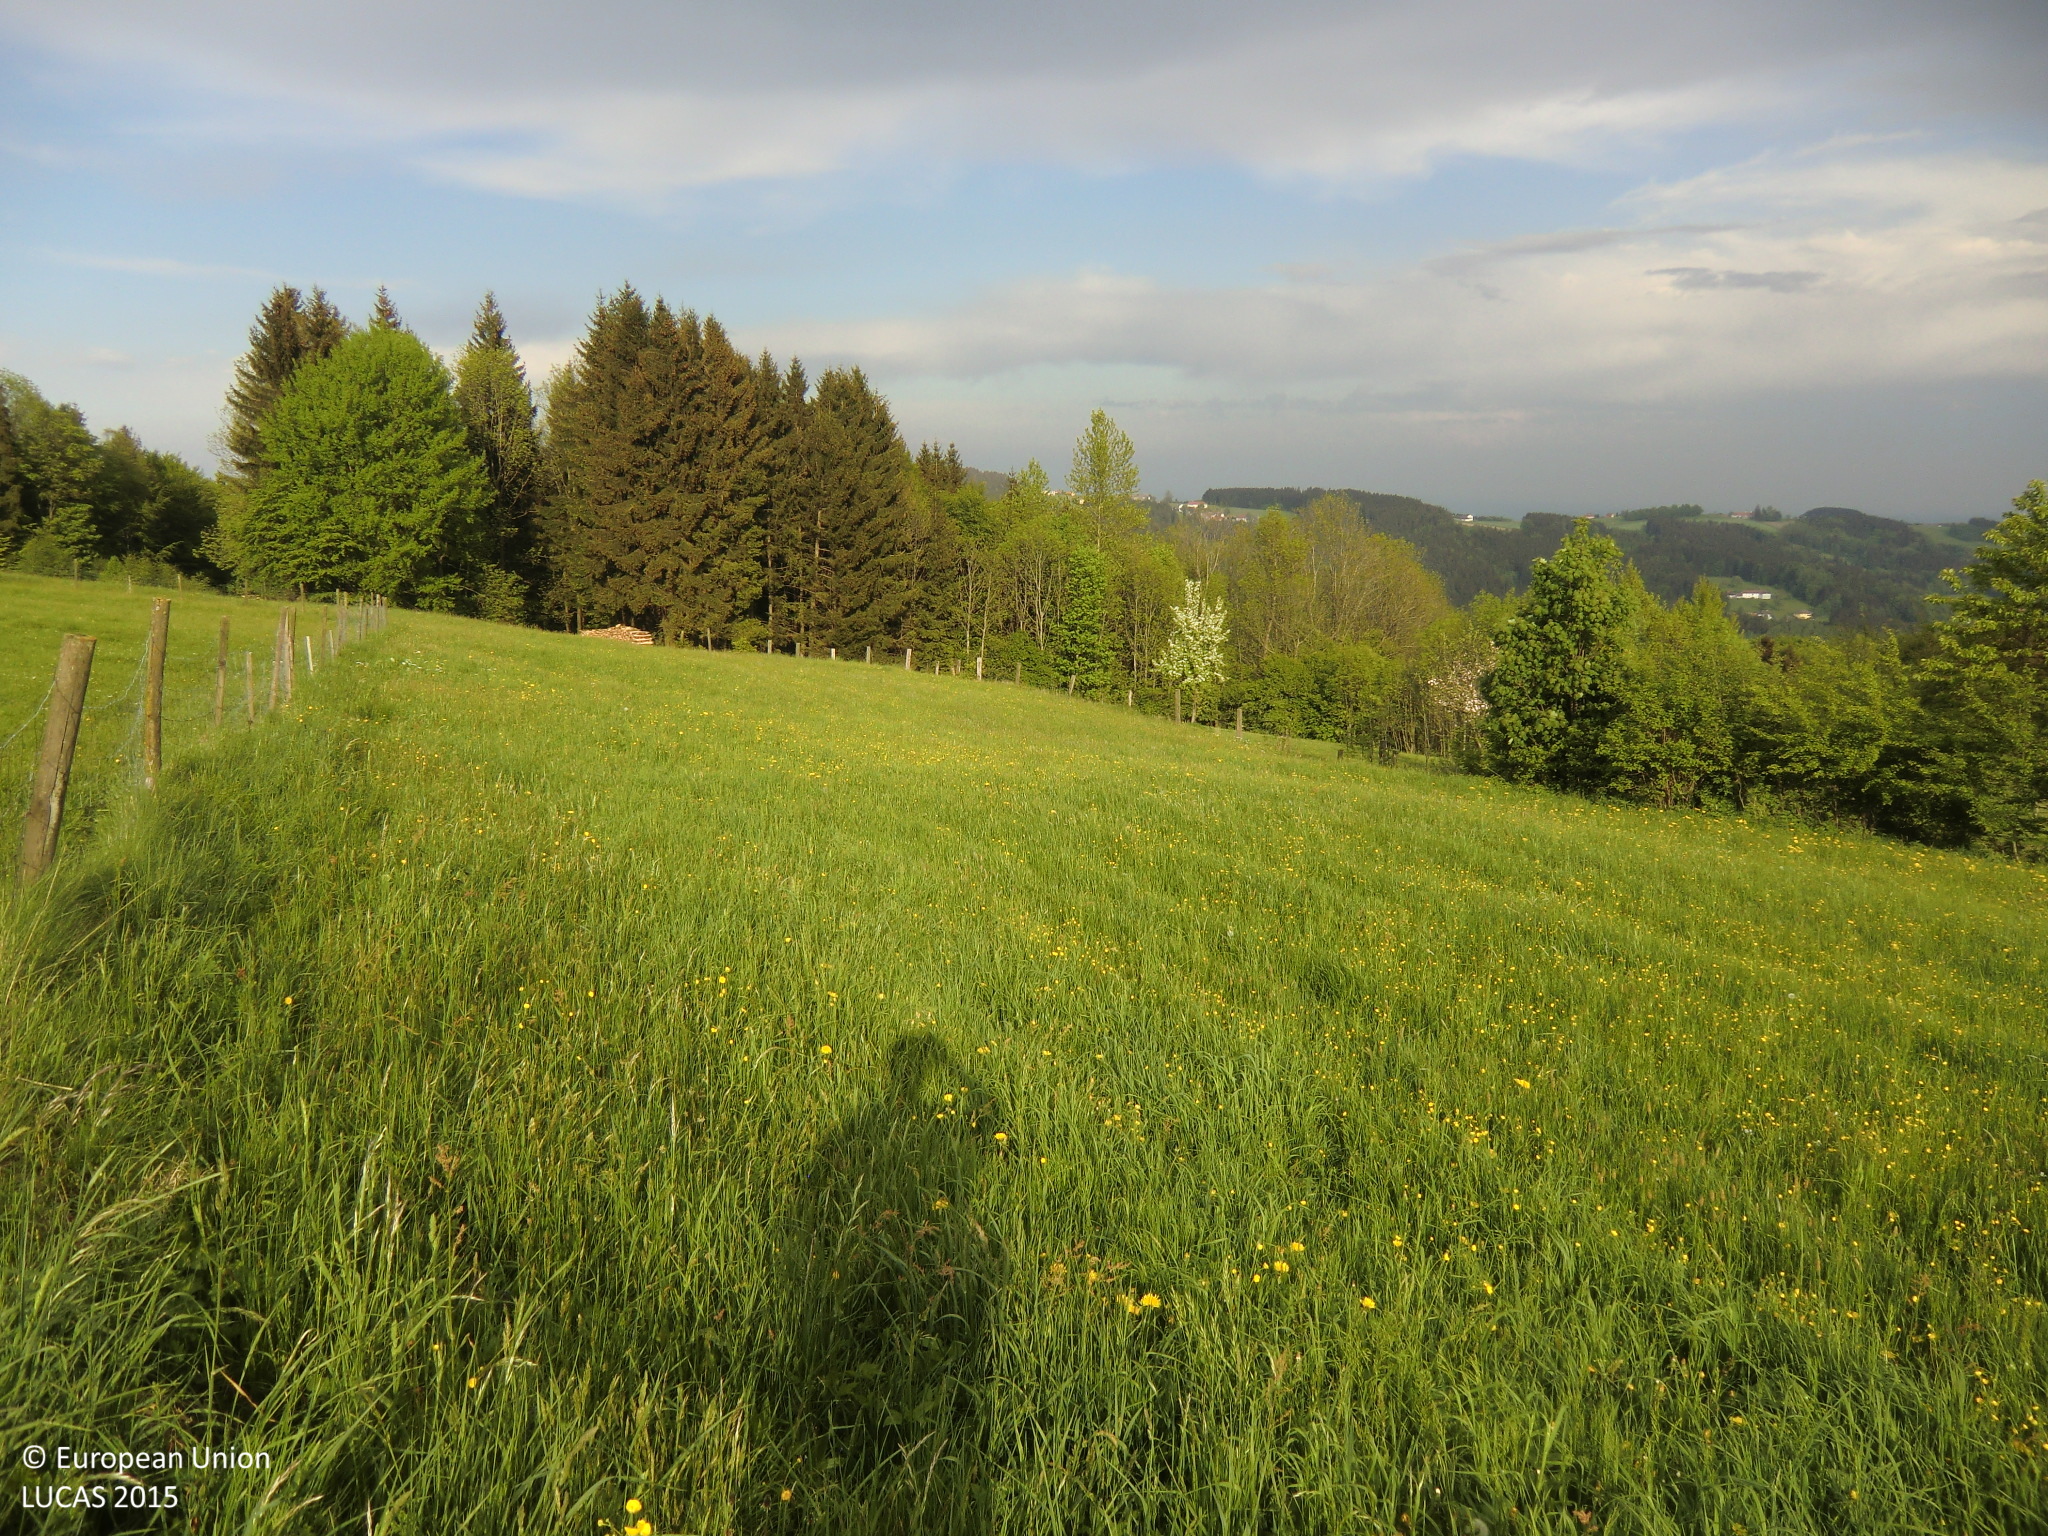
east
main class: Grassland
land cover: Grassland without tree/shrub cover
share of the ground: > 75 %
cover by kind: herbaceous plants 100 %
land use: Agriculture (excluding fallow land and kitchen gardens)
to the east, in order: Grassland without tree/shrub cover; Fences; Grassland without tree/shrub cover; Fences; Spruce dominated coniferous woodland; Tracks; Spruce dominated coniferous woodland; Fences; Tracks
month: May
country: AT
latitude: 48.4106
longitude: 14.2829
